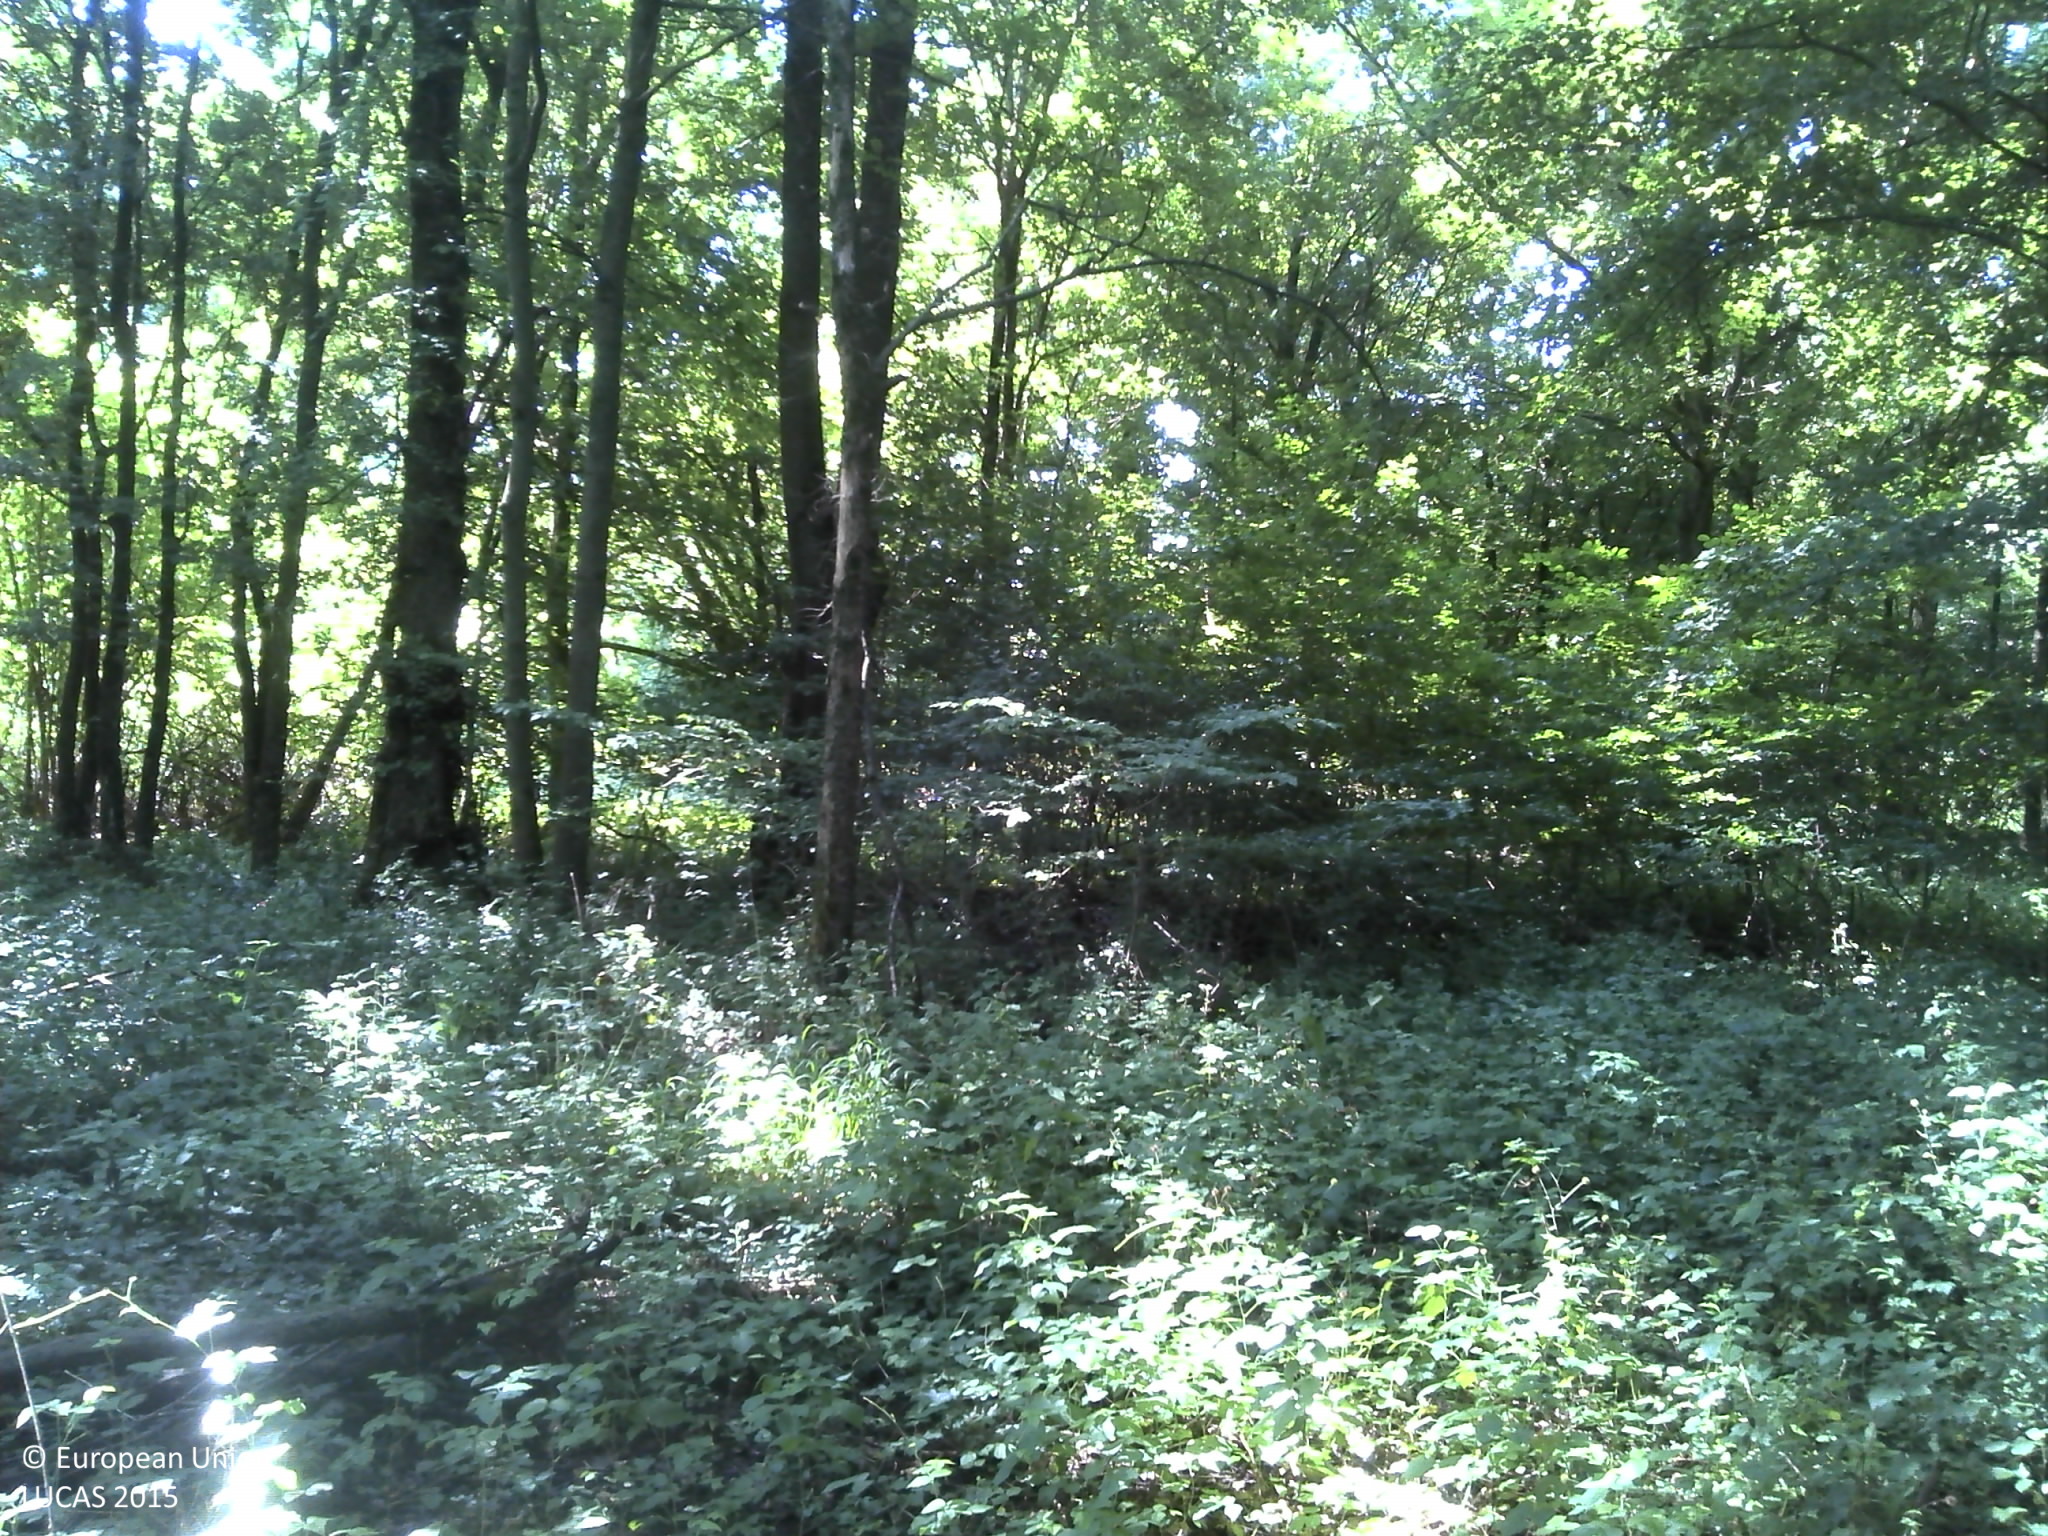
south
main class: Woodland
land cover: Broadleaved woodland
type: mesophytic deciduous forest
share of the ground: > 75 %
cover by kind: broadleaved forest trees 90 %, shrubs 5 %, herbaceous plants 5 %
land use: Forestry
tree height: > 5 m
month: July
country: HR
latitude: 45.8219
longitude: 16.8864
